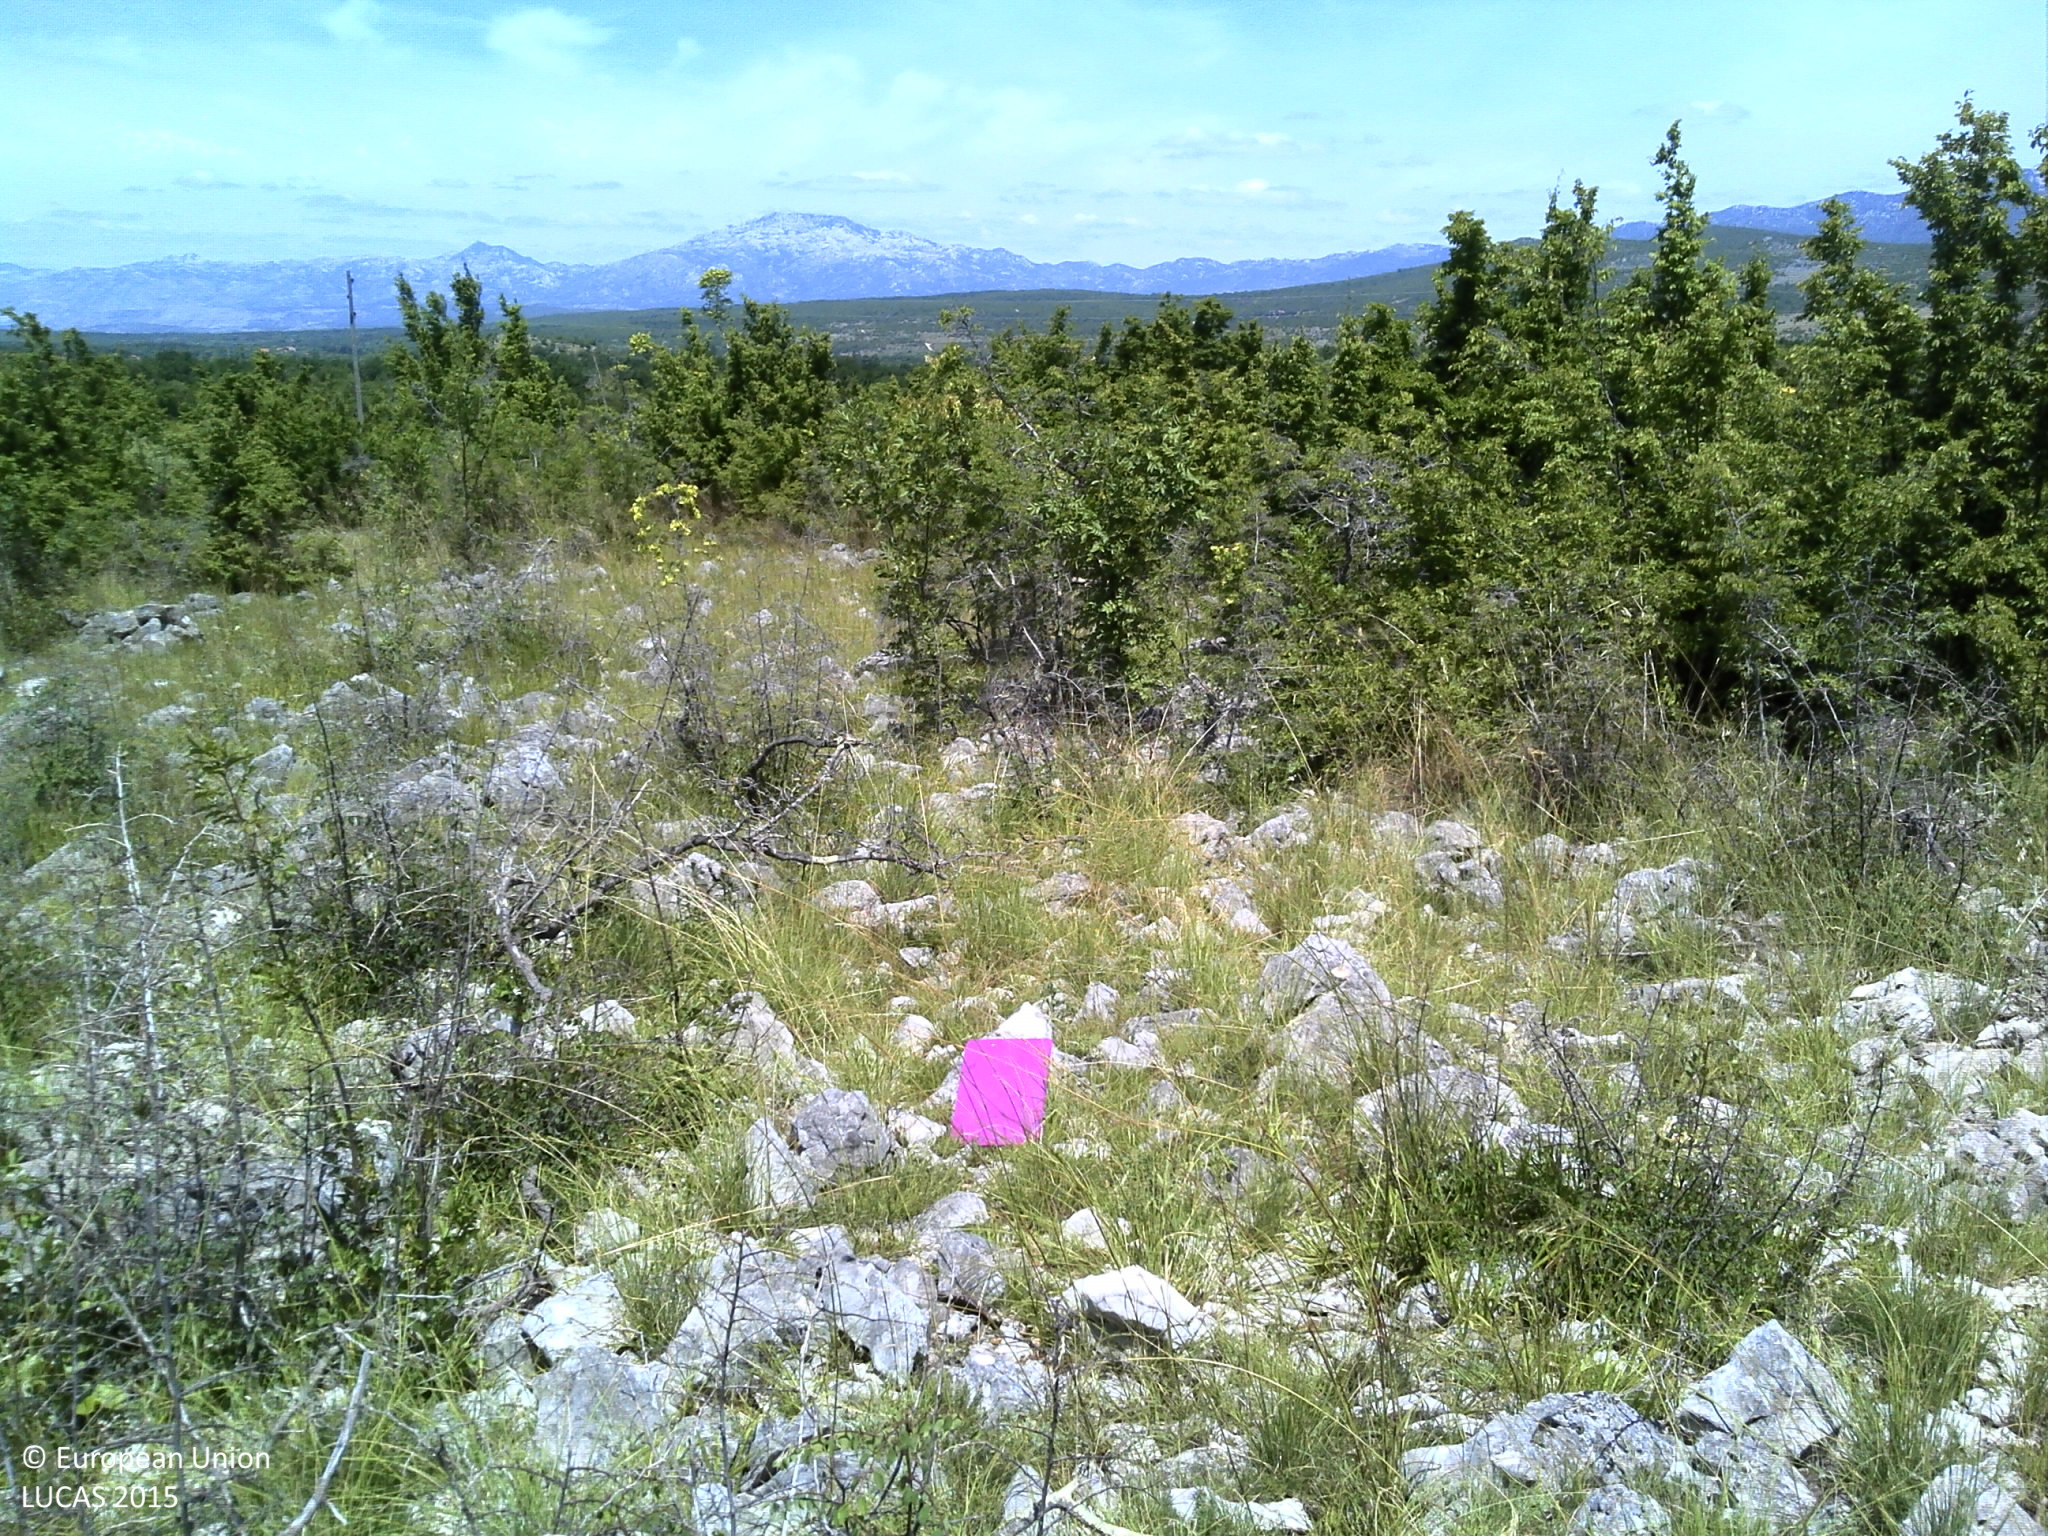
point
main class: Shrubland
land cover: Shrubland with sparse tree cover
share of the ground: 50 - 75 %
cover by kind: shrubs 35 %, unconsolidated bare surface 30 %, herbaceous plants 20 %, consolidated bare surface 10 %, broadleaved forest trees 5 %
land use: Semi-natural and natural areas not in use
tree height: < 5 m
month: June
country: HR
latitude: 44.0894
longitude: 15.9499
